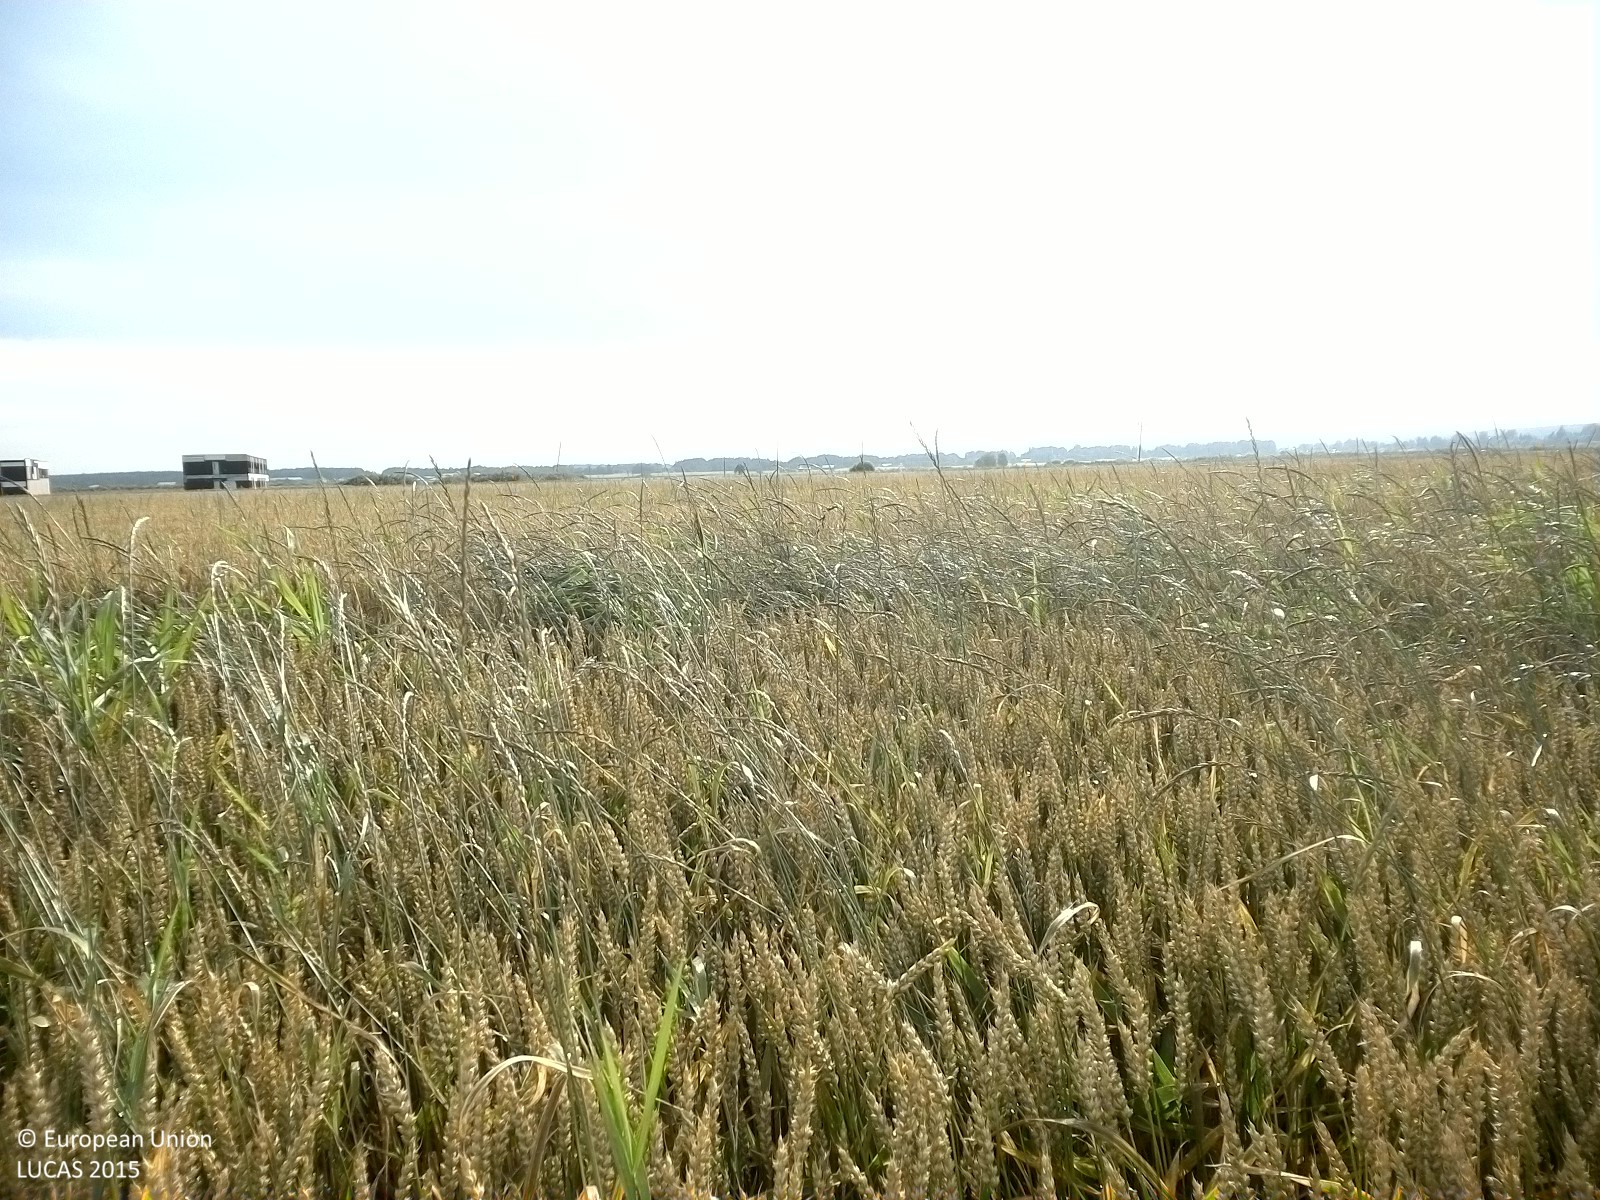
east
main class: Cropland
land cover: Common wheat
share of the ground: > 75 %
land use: Agriculture (excluding fallow land and kitchen gardens)
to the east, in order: Common wheat; Grass margins; Common wheat
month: August
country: SE
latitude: 59.0782
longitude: 15.1041
